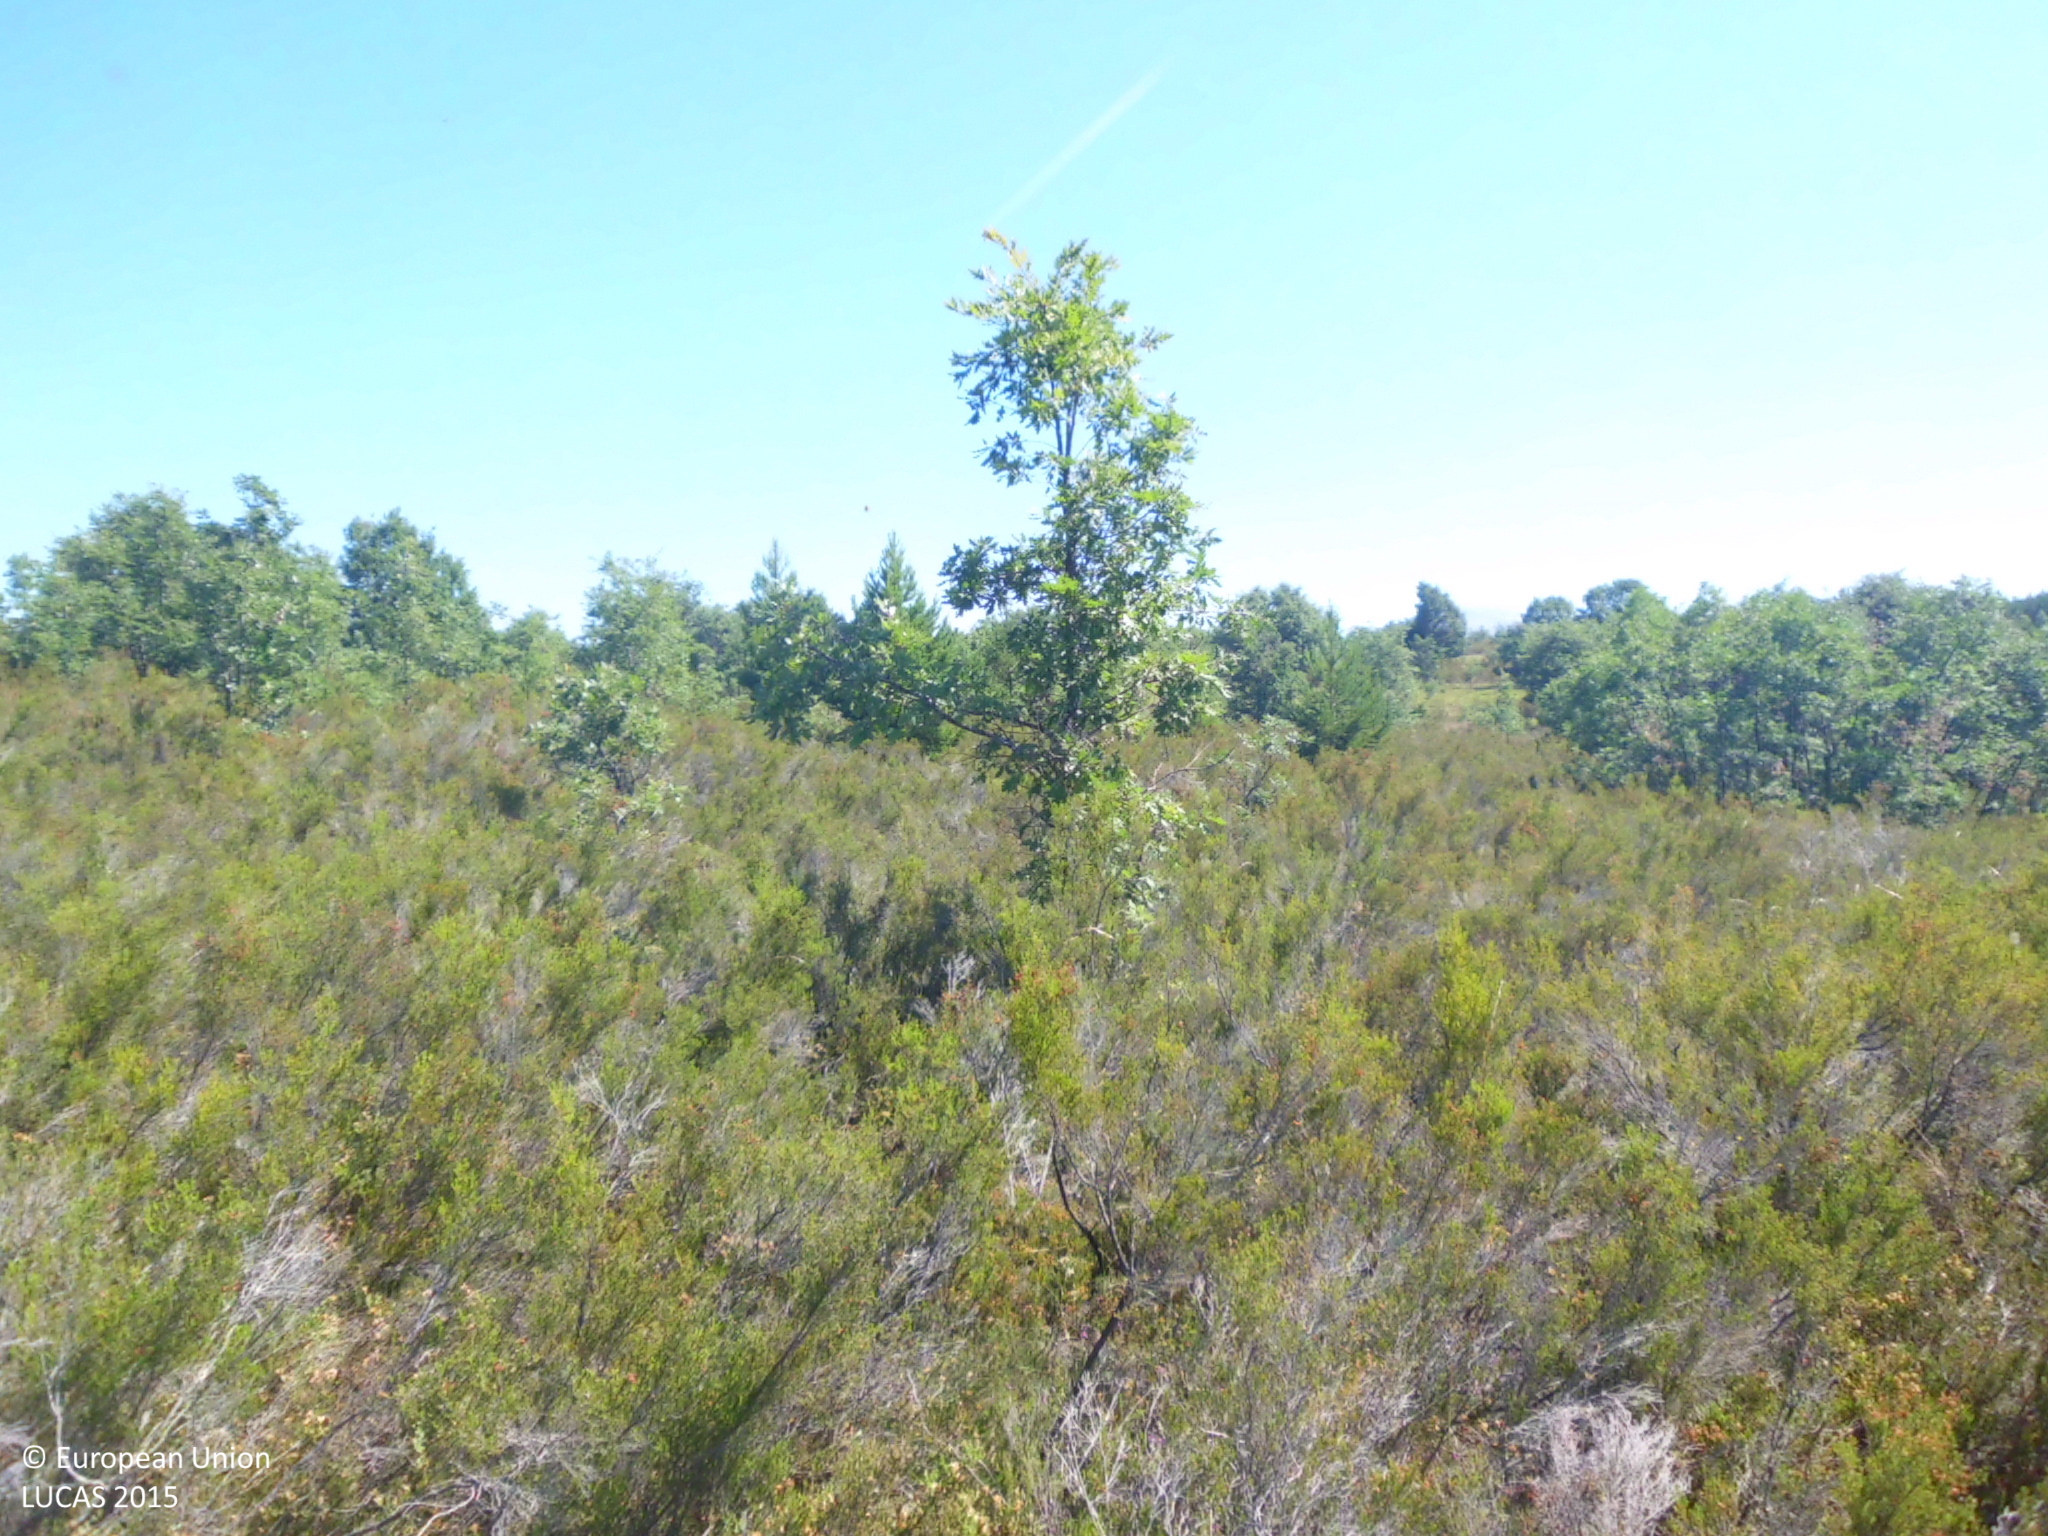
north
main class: Shrubland
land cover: Shrubland without tree cover
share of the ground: > 75 %
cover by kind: shrubs 95 %, herbaceous plants 5 %
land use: Abandoned areas
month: June
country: ES
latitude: 42.7714
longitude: -4.9107
